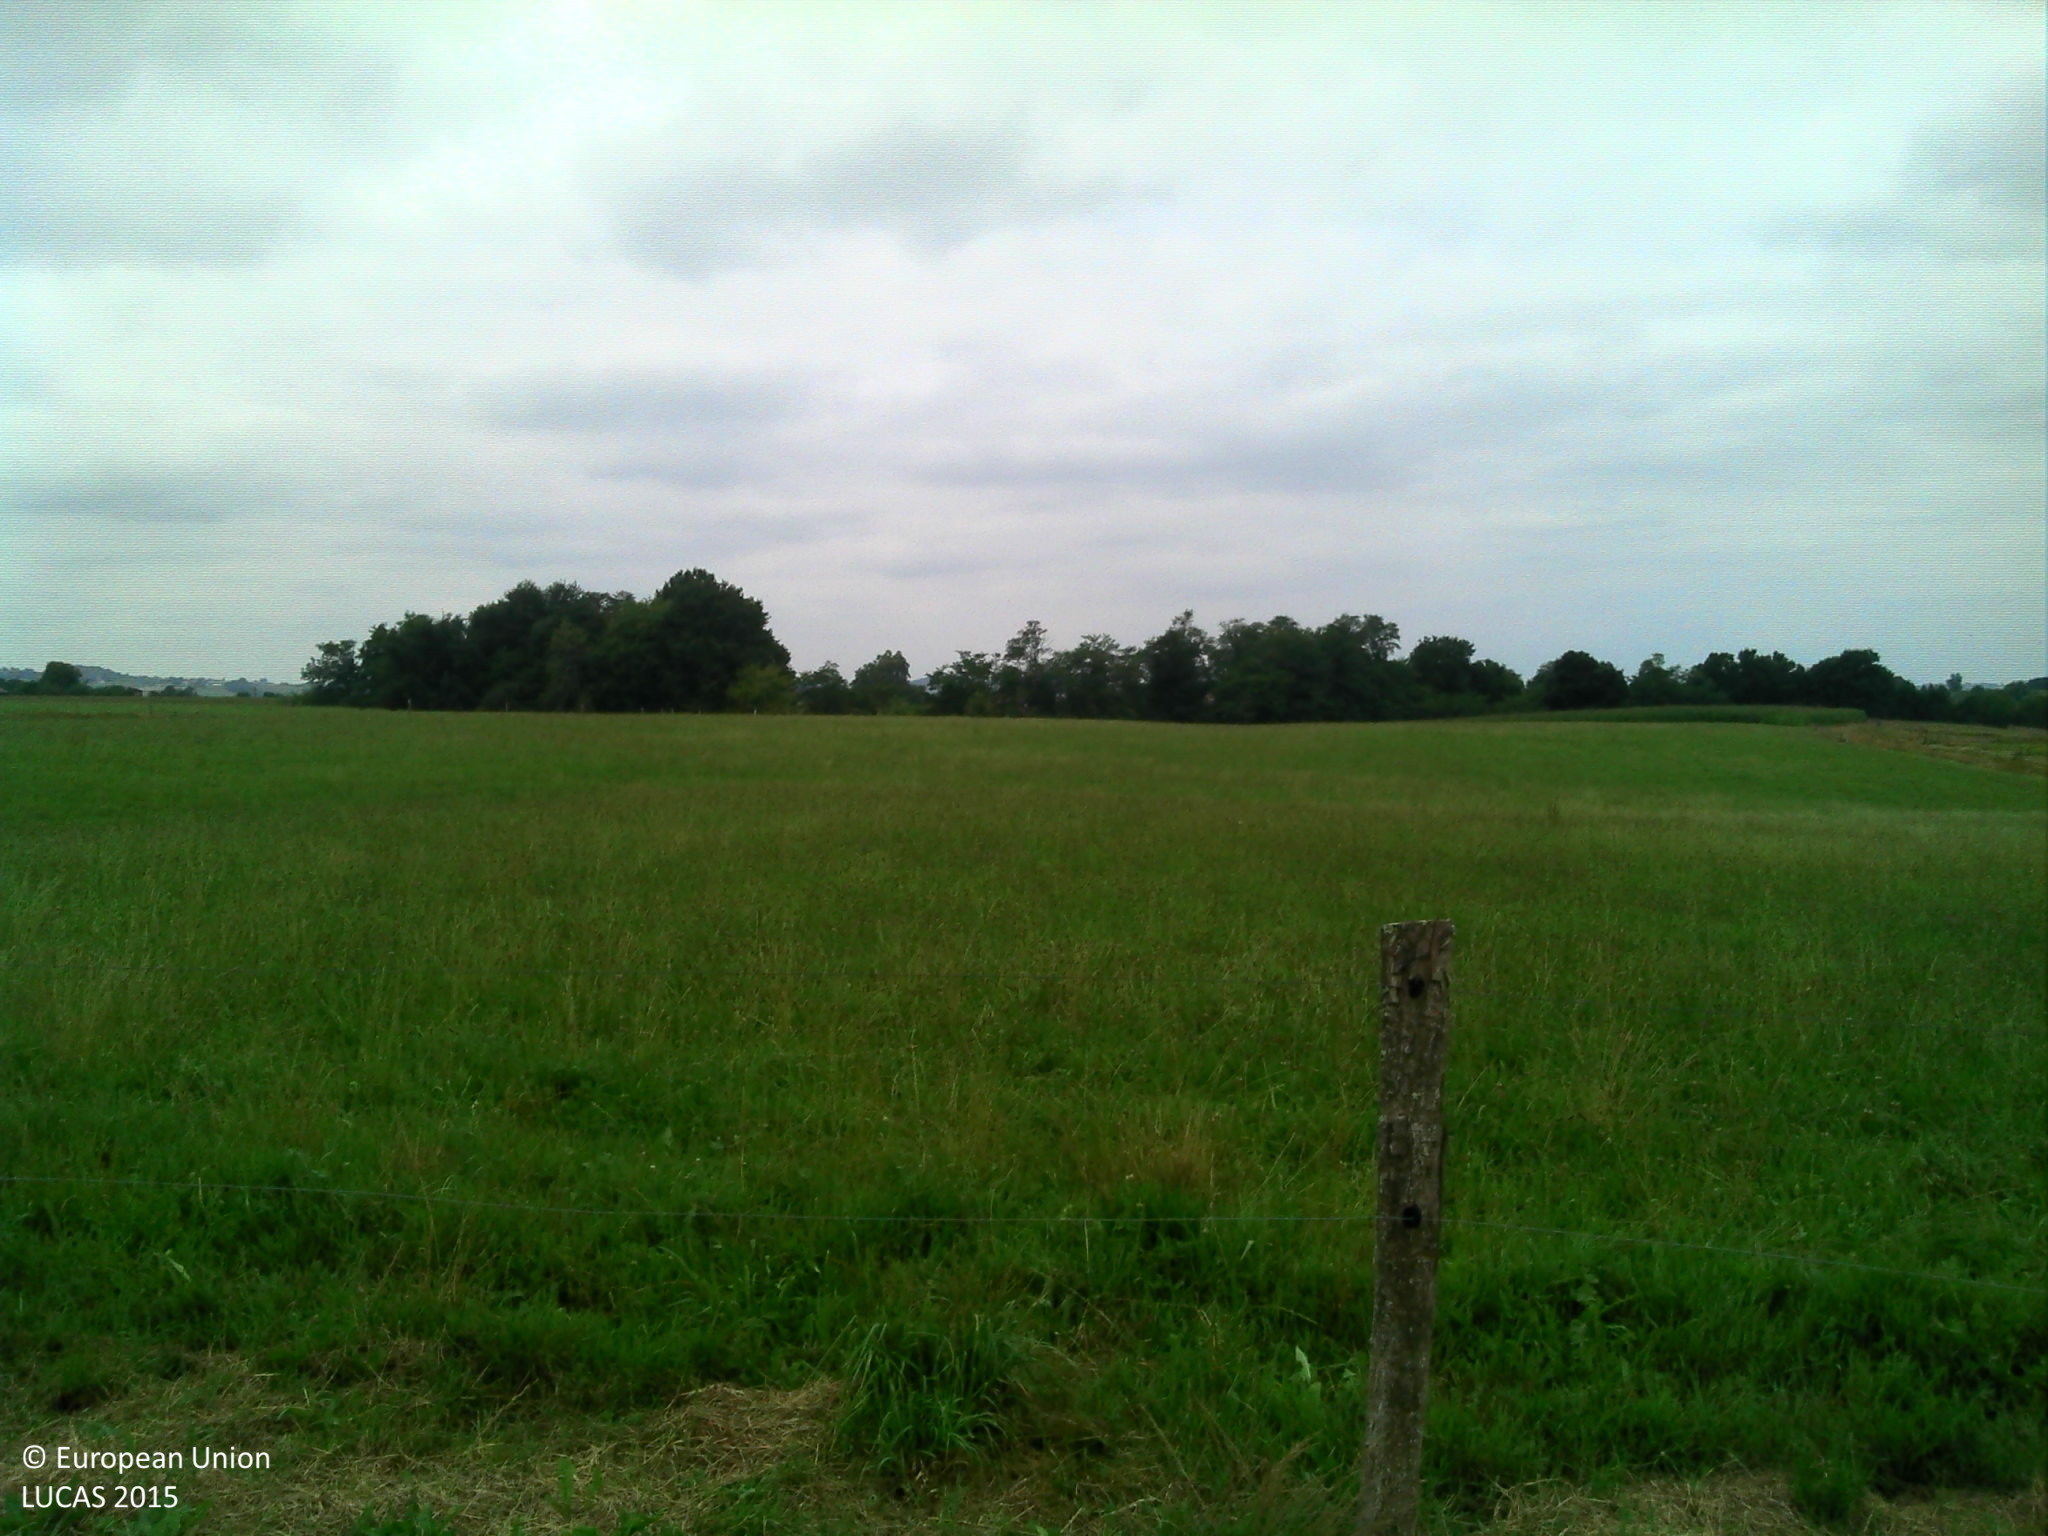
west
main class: Grassland
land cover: Grassland without tree/shrub cover
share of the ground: > 75 %
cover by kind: herbaceous plants 100 %
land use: Agriculture (excluding fallow land and kitchen gardens)
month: August
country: FR
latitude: 43.4976
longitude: -1.1078
